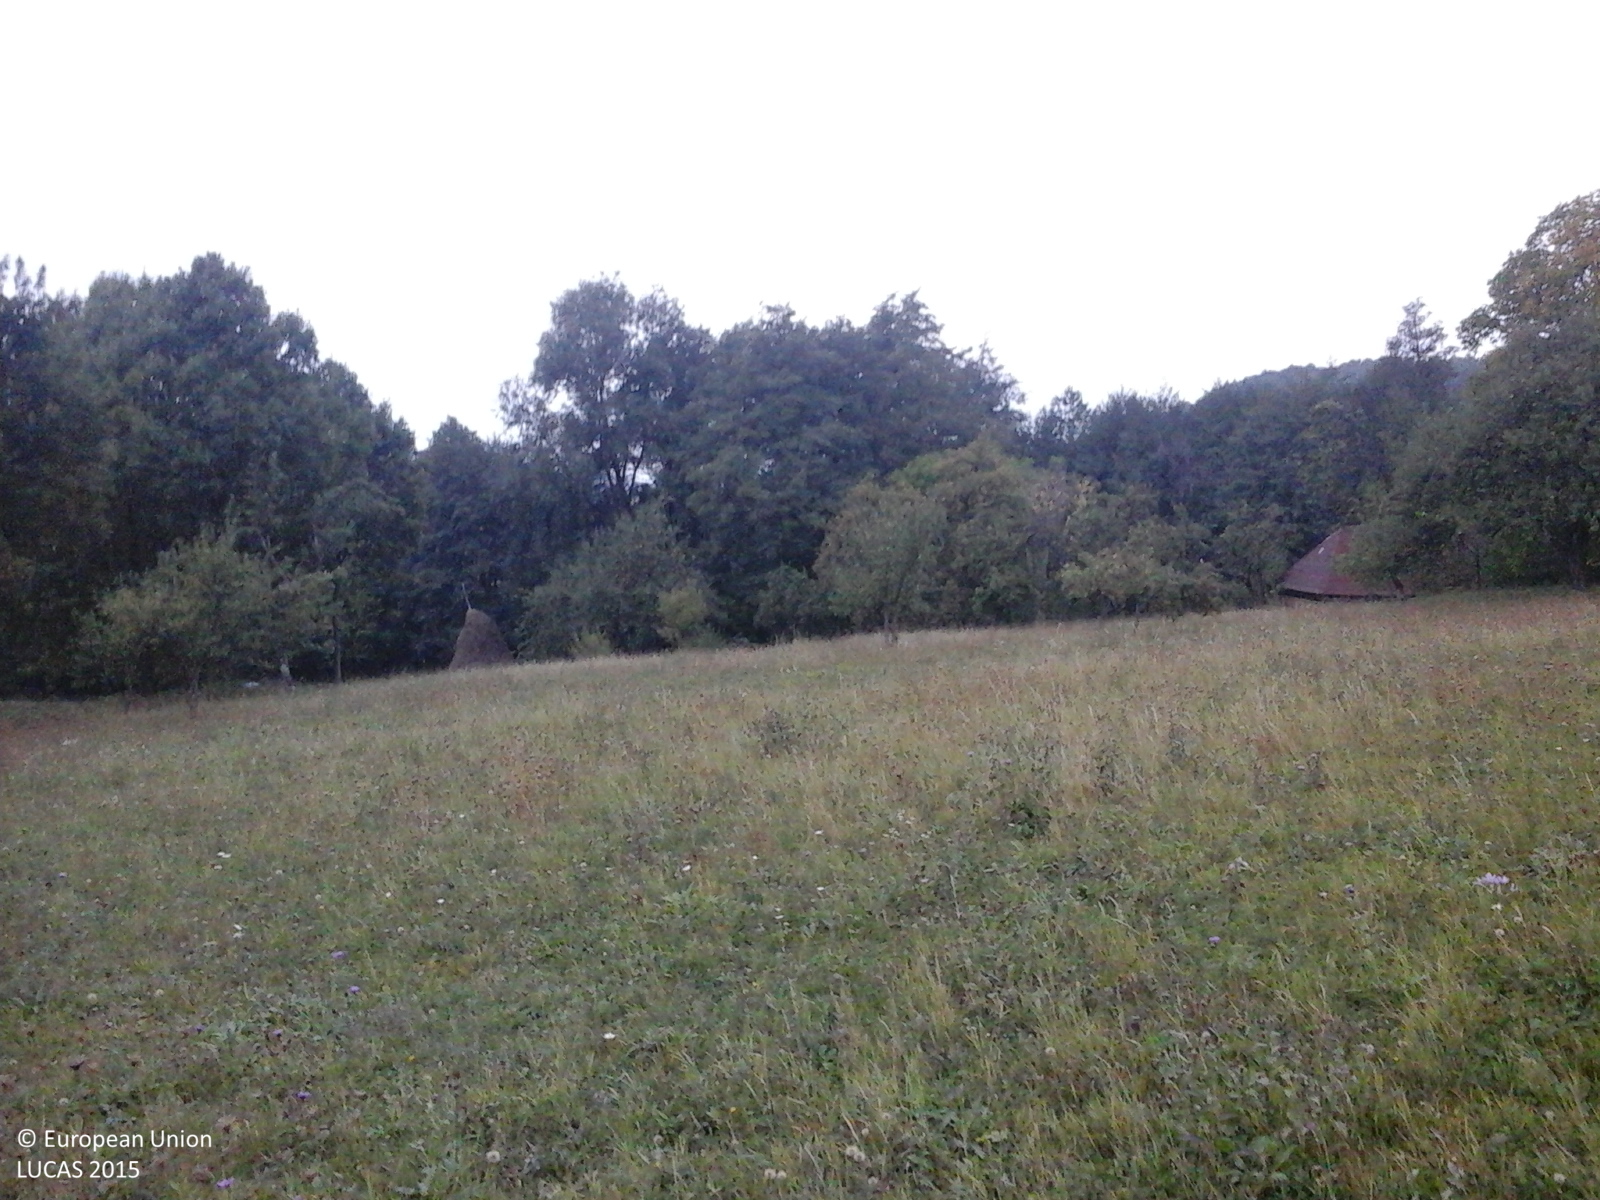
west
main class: Grassland
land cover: Grassland without tree/shrub cover
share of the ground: > 75 %
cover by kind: herbaceous plants 100 %
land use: Agriculture (excluding fallow land and kitchen gardens)
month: October
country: RO
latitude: 46.7667
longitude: 25.0141
